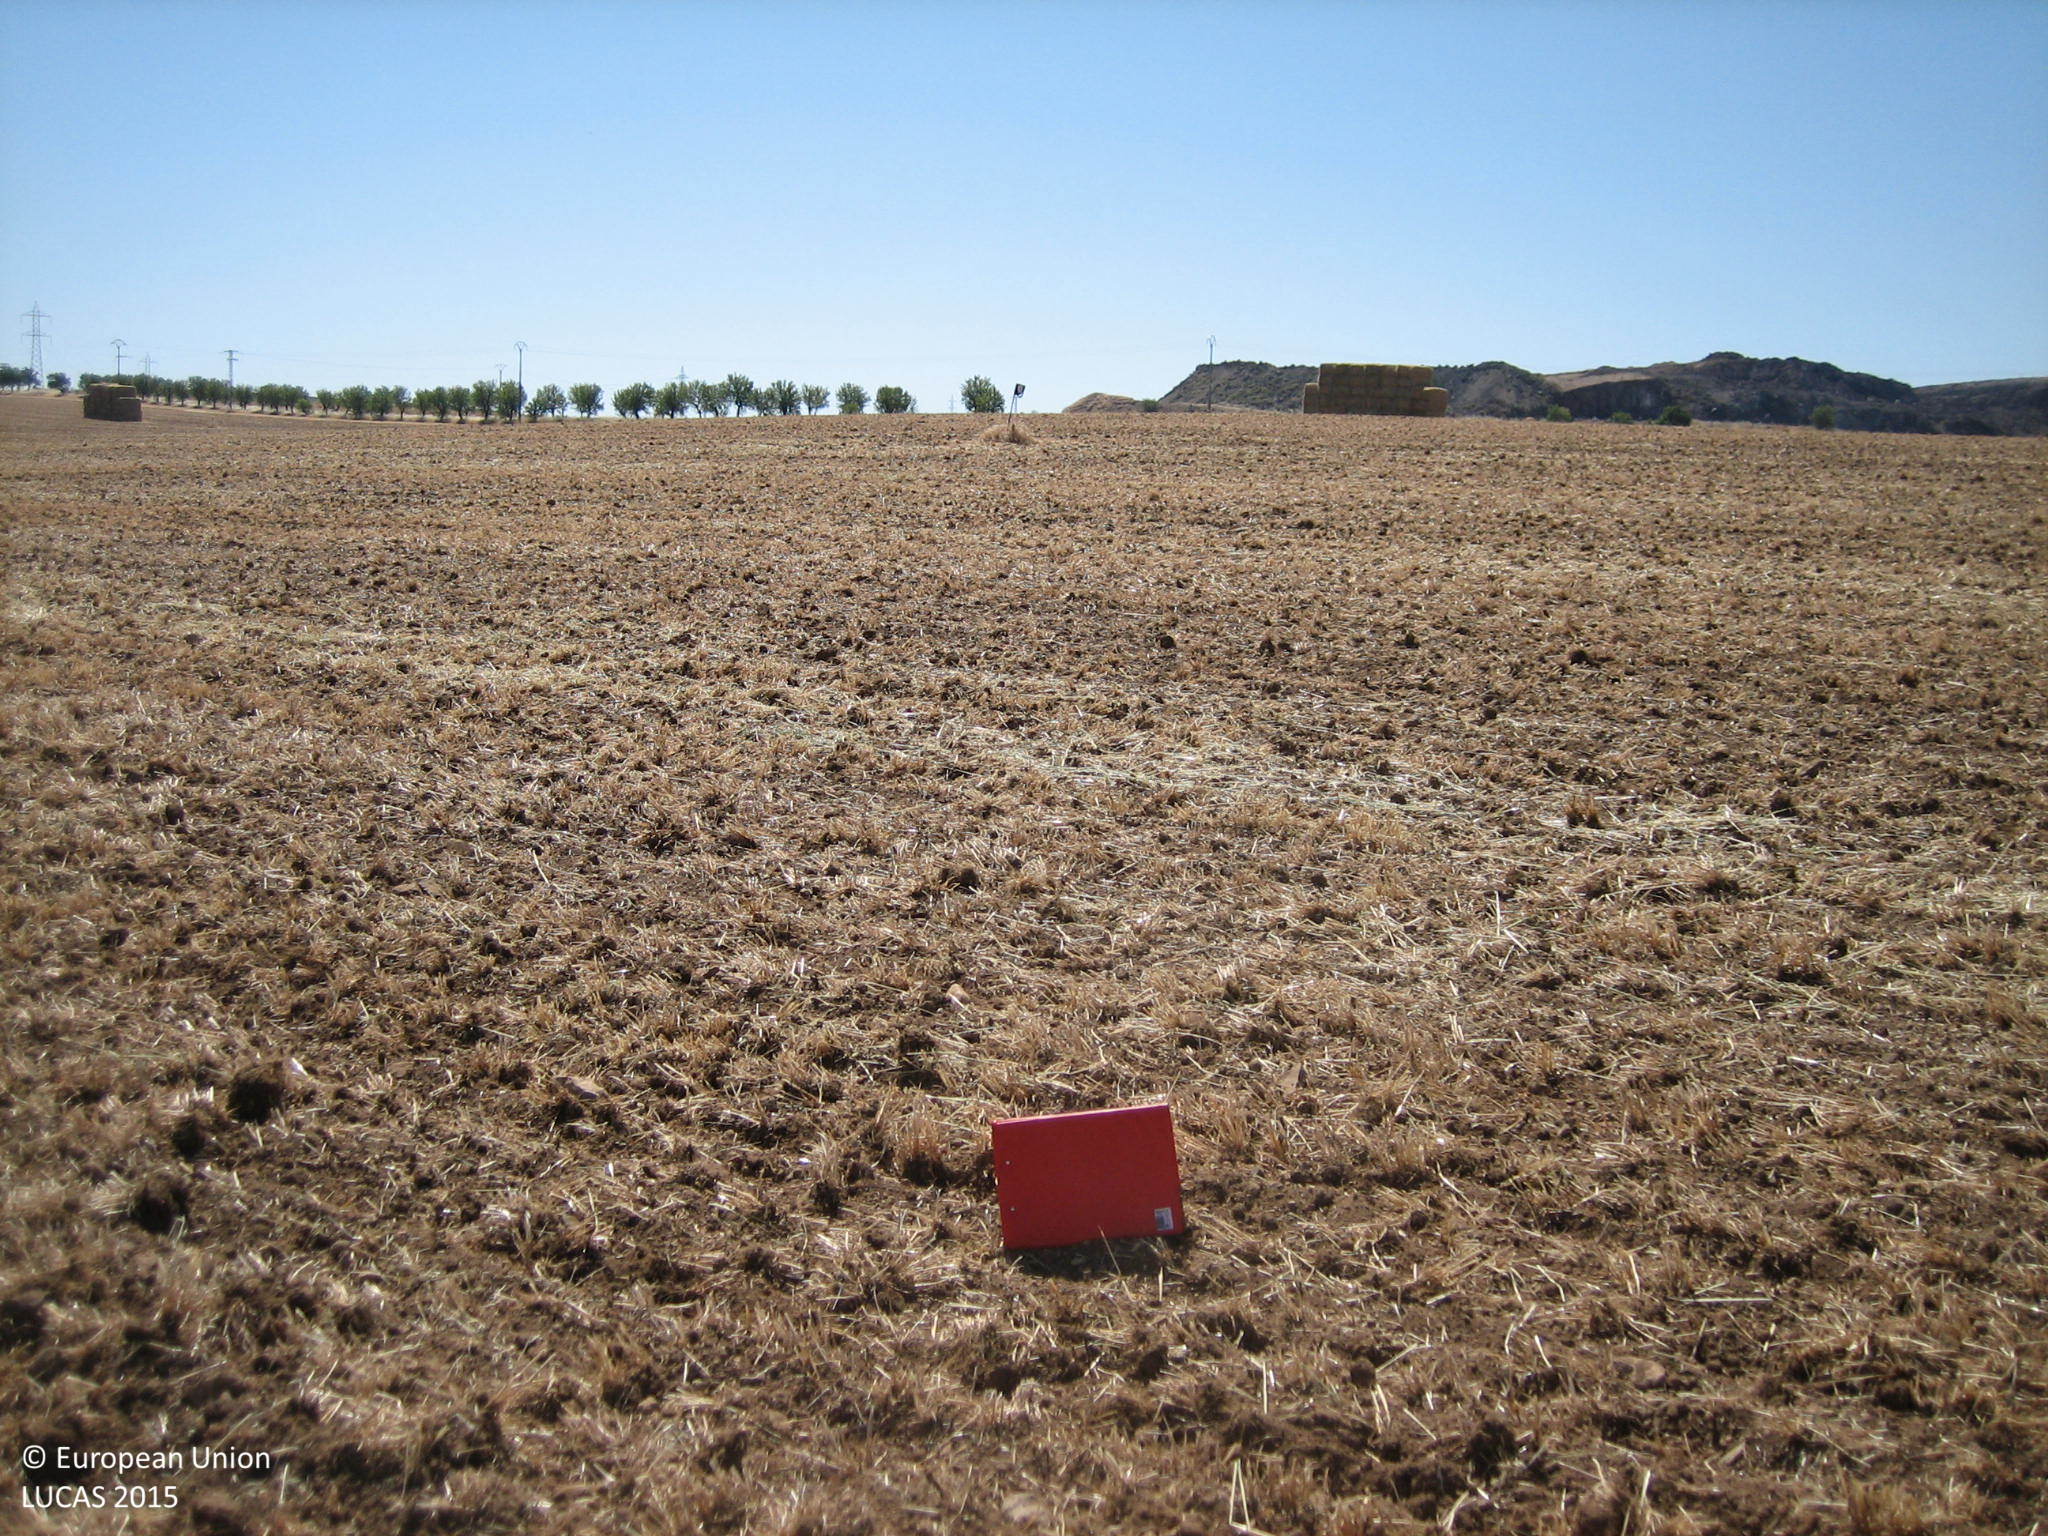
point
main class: Cropland
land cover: Oats
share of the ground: > 75 %
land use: Agriculture (excluding fallow land and kitchen gardens)
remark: Harvested field
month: May
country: ES
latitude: 38.9650
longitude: -3.9972
